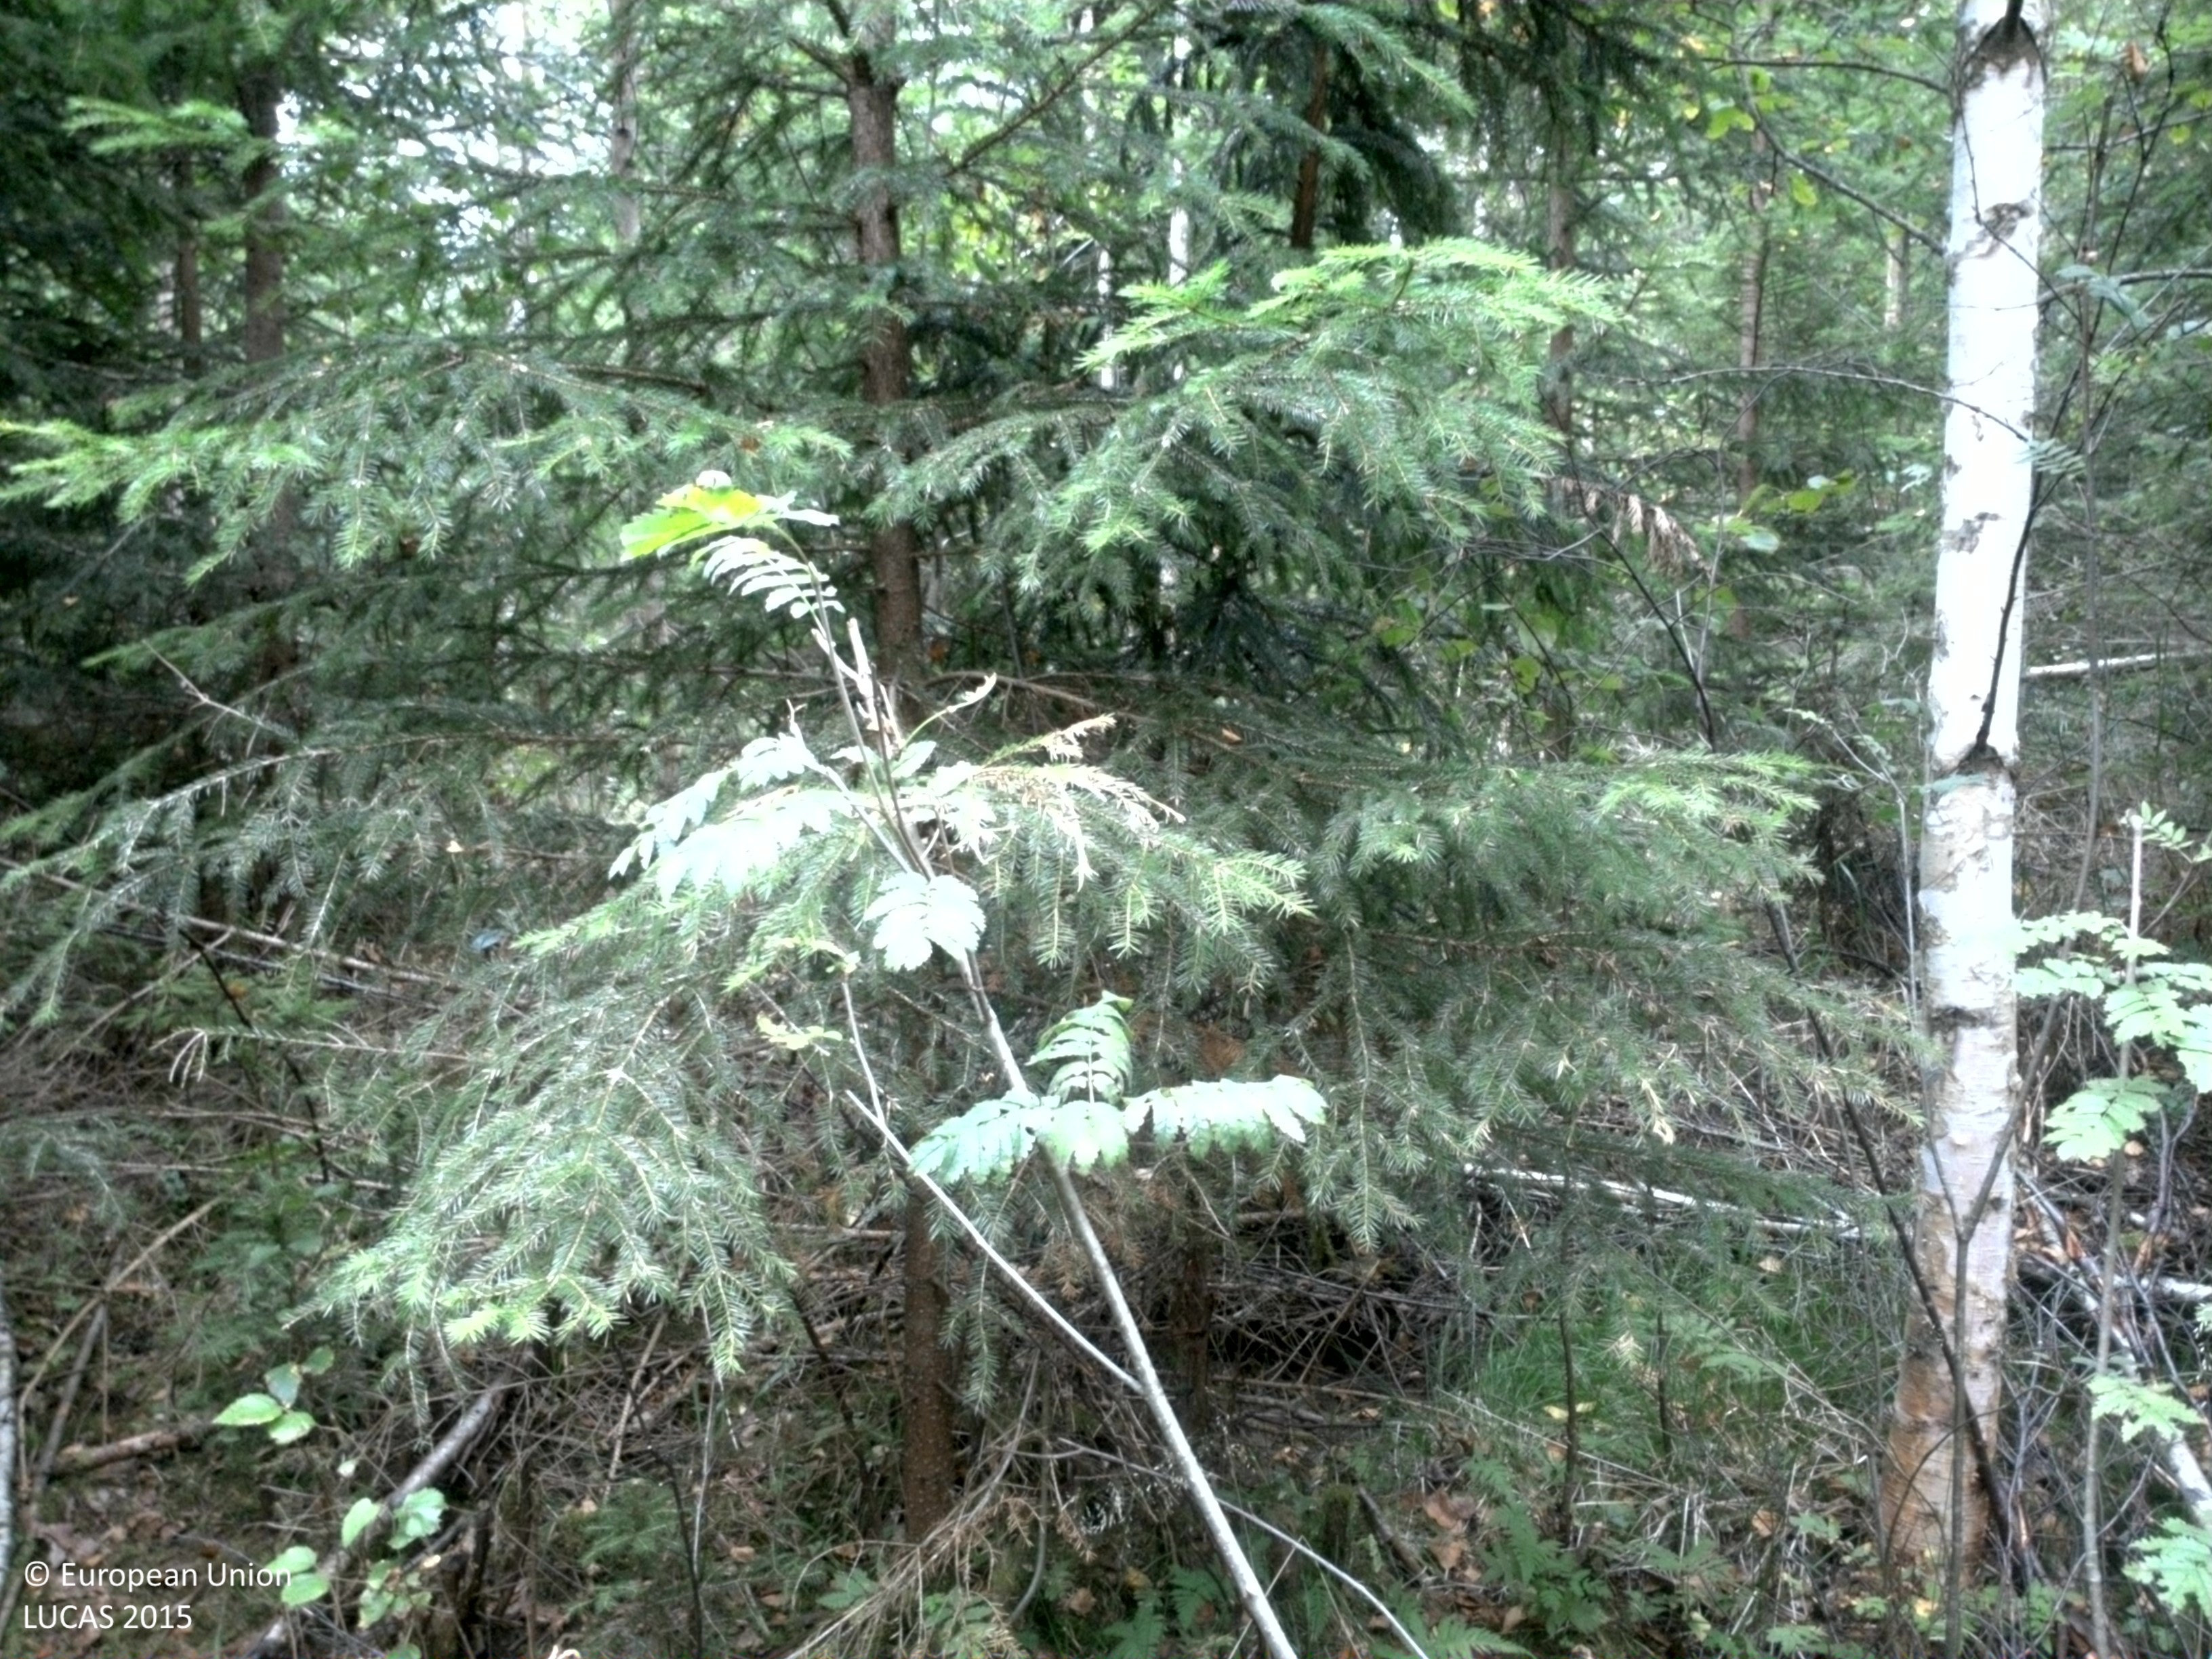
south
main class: Woodland
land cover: Spruce dominated mixed woodland
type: boreal forest
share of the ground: 50 - 75 %
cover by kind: coniferous forest trees 50 %, broadleaved forest trees 20 %, herbaceous plants 20 %, lichens and mosses 10 %
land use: Forestry
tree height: > 5 m
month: August
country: SE
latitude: 59.5972
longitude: 13.4816
